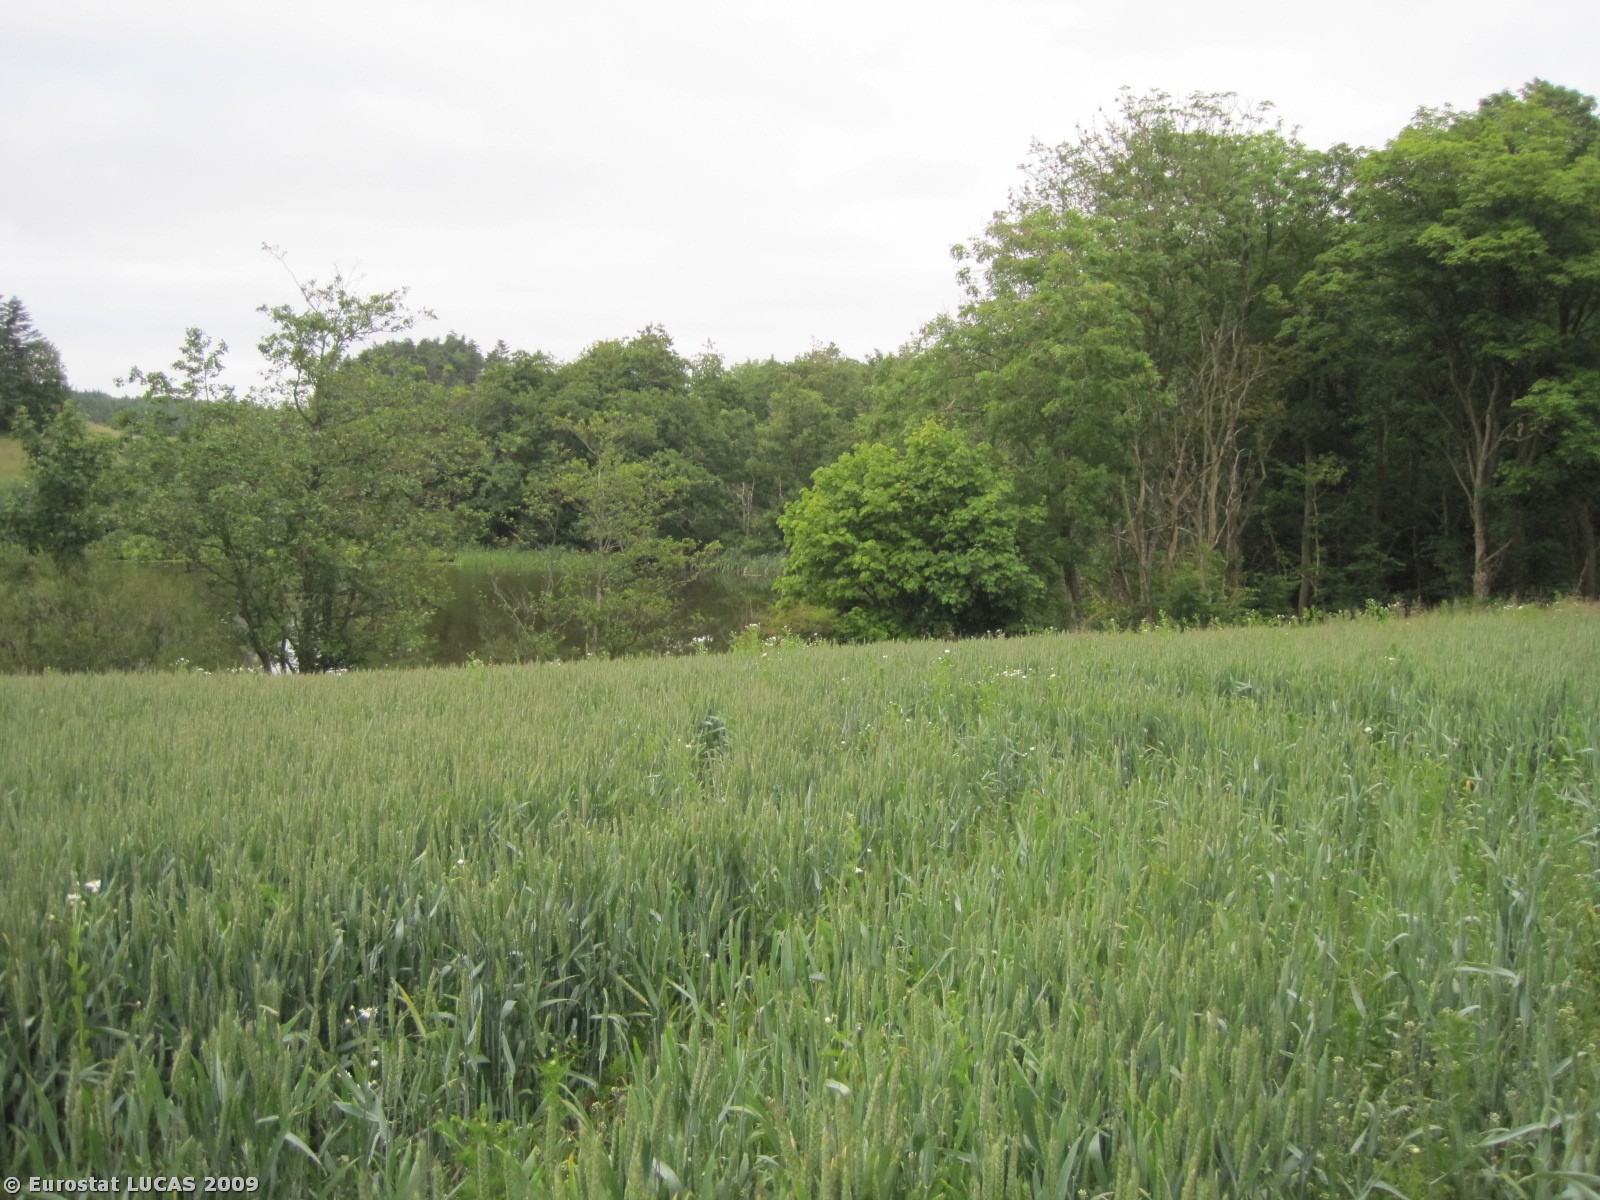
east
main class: Cropland
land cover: Common wheat
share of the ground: > 75 %
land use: Agriculture (excluding fallow land and kitchen gardens)
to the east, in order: Common wheat; Grass margins; Broadleaved woodland; Grass margins; Inland water bodies; Grass margins; Broadleaved woodland; Tracks; Broadleaved woodland; Grassland without tree/shrub cover; Broadleaved woodland; Shrubland without tree cover; Artificial constructions in urban areas; Grassland without tree/shrub cover; Broadleaved woodland; Tracks; Broadleaved woodland
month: June
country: DK
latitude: 56.7392
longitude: 8.7755
